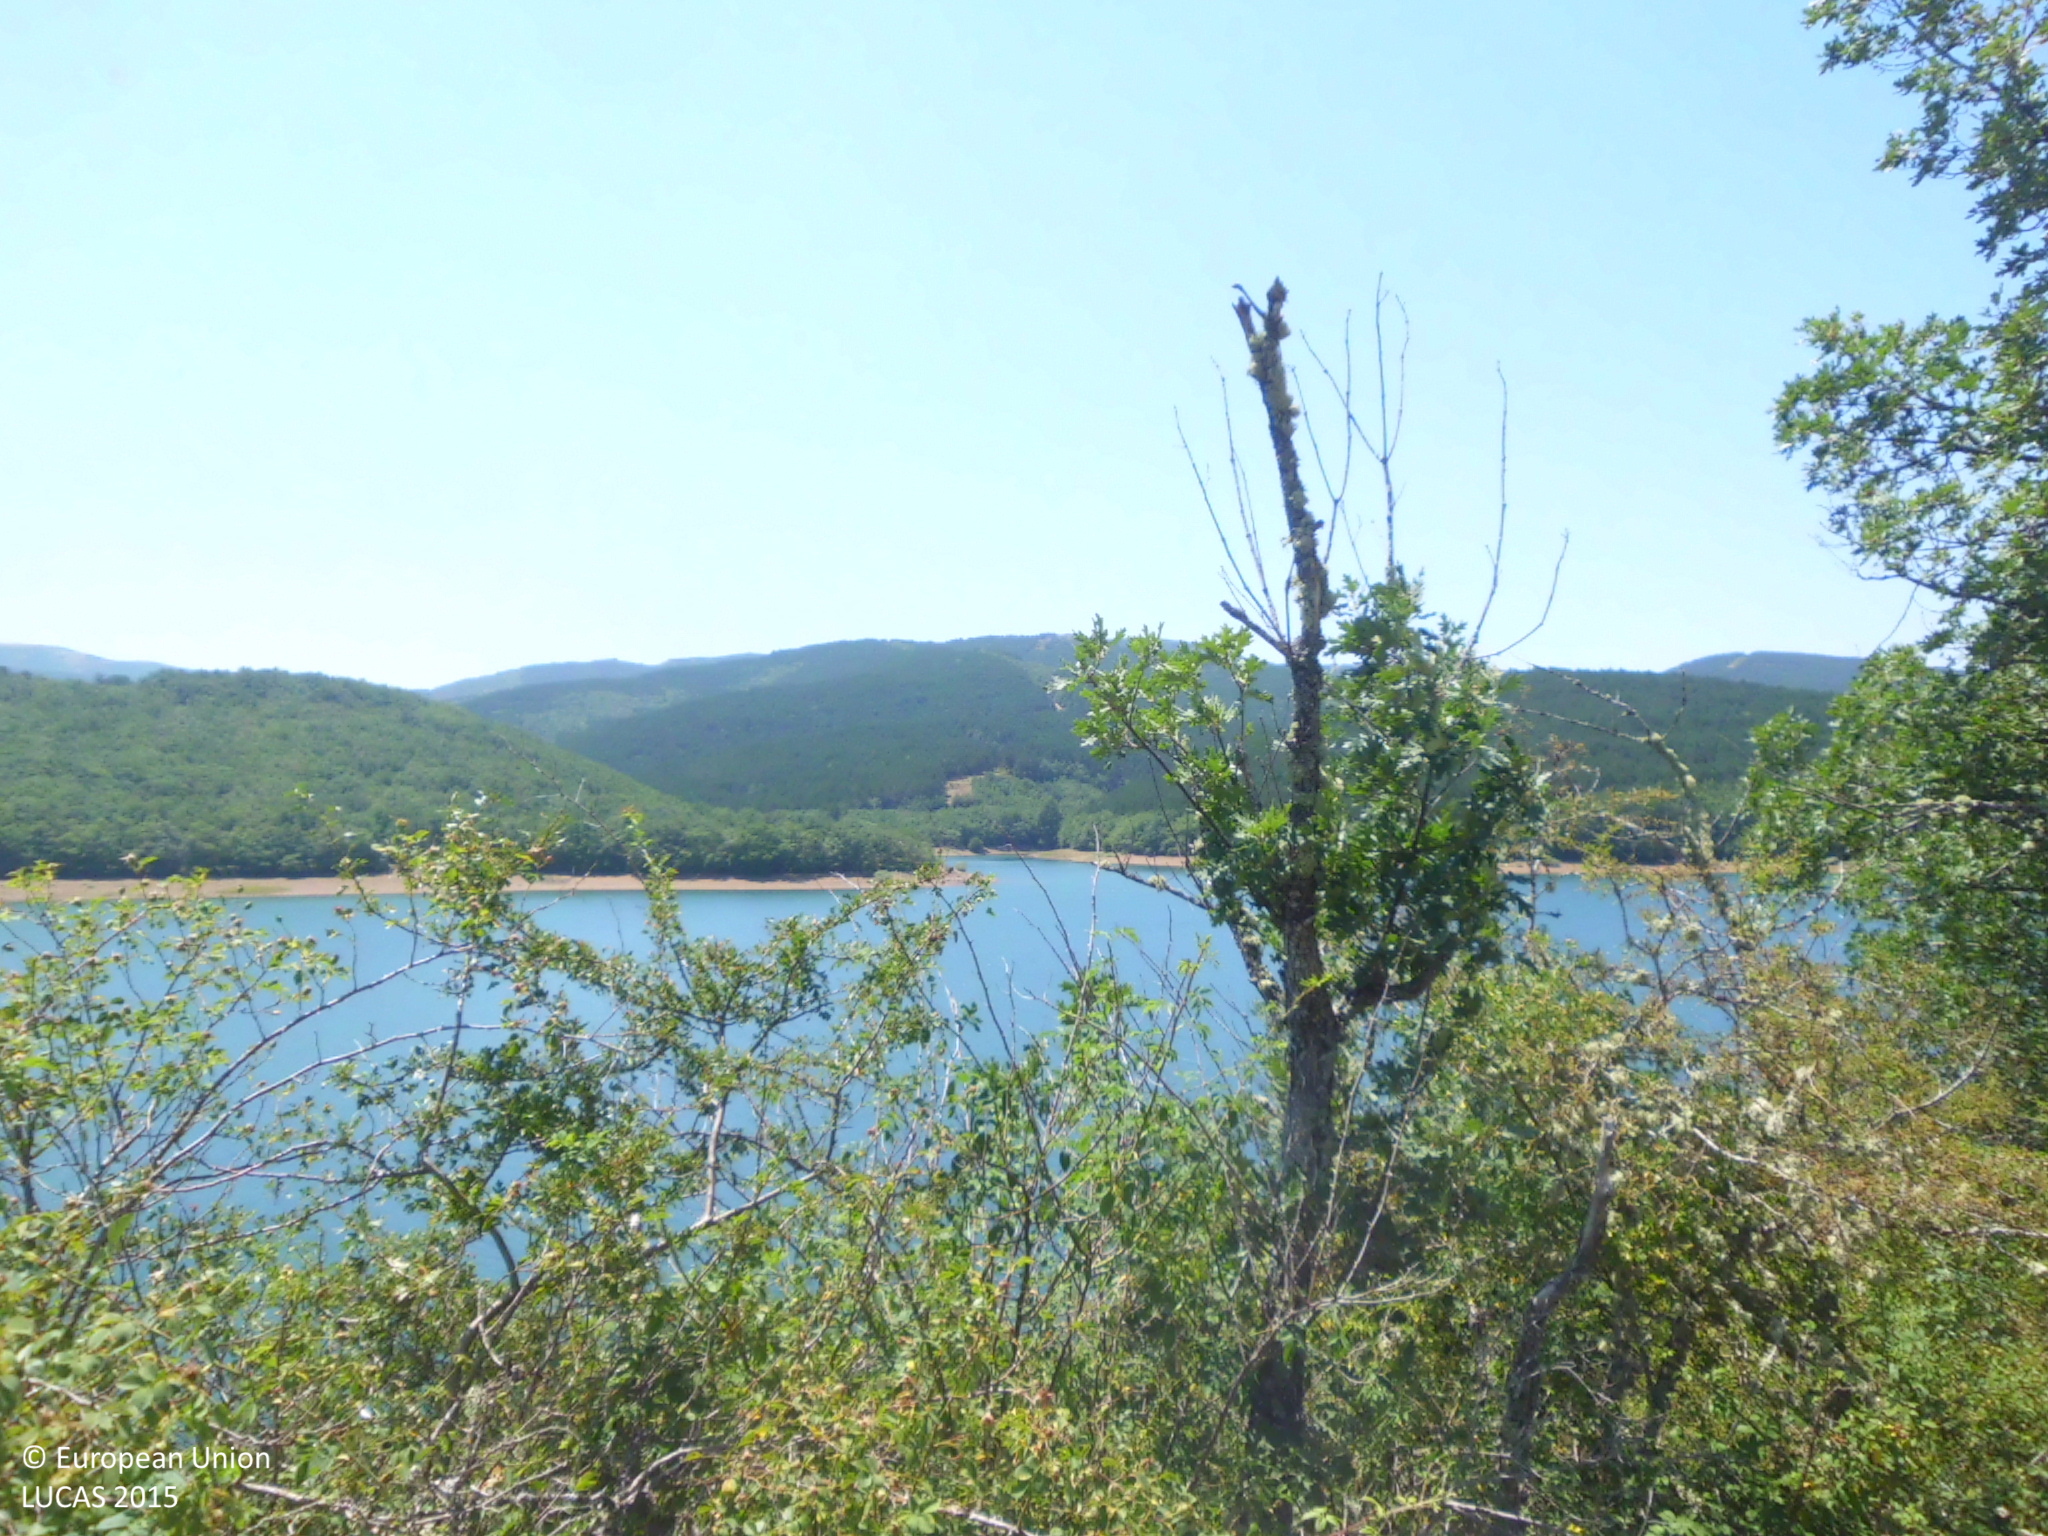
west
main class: Woodland
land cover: Pine dominated coniferous woodland
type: coniferous forest of the mediterranean region
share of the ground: > 75 %
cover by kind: coniferous forest trees 100 %
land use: Forestry
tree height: > 5 m
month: July
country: ES
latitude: 42.2413
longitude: -3.3485
